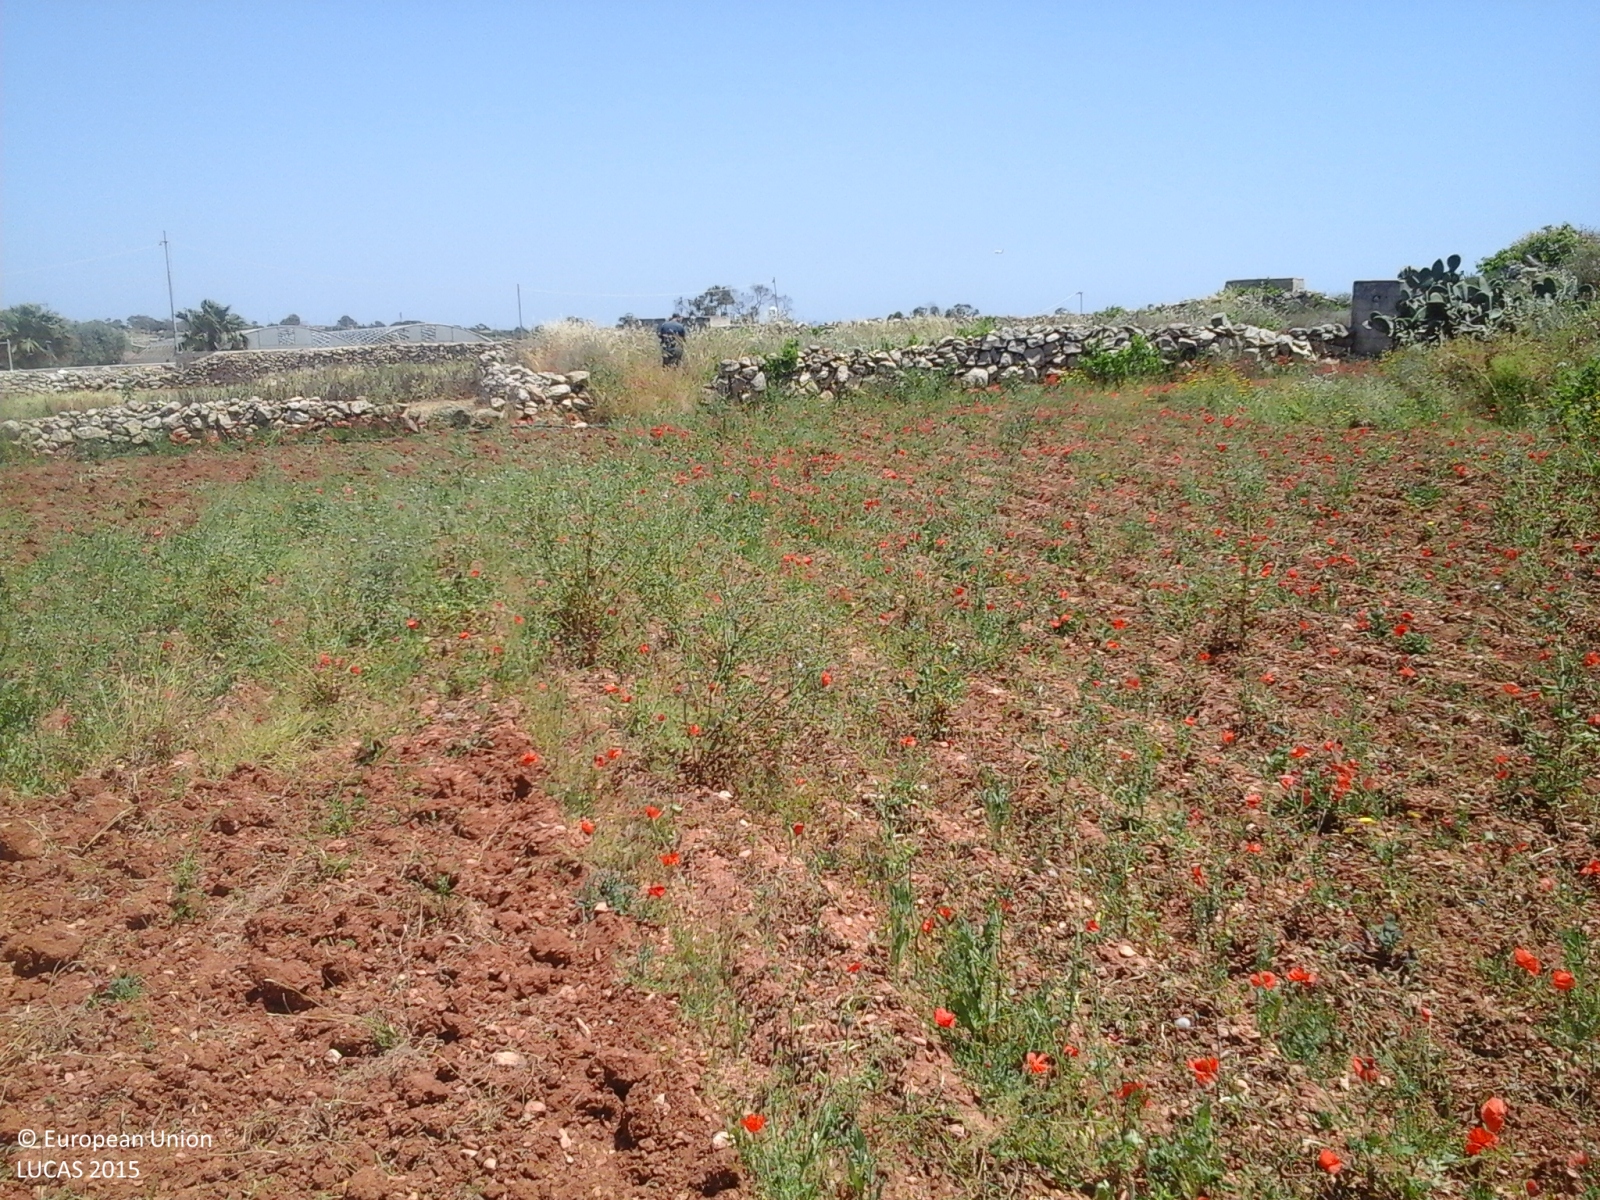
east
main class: Cropland
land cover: Olive groves
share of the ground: 10 - 25 %
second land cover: Spontaneously vegetated surfaces
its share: 10 - 25 %
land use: Agriculture (excluding fallow land and kitchen gardens)
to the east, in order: Olive groves; Spontaneously vegetated surfaces; Dry stone walls; Potatoes; Dry stone walls; Spontaneously vegetated surfaces; Dry stone walls; Mixed cereals for fodder; Tracks; Potatoes; Dry stone walls; Spontaneously vegetated surfaces; Dry stone walls; Potatoes; Dry stone walls; Potatoes; Dry stone walls; Single bushes/trees; Artificial constructions in urban areas; Other leguminous and mixtures for fodder; Dry stone walls
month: May
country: MT
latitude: 35.8218
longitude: 14.4852
